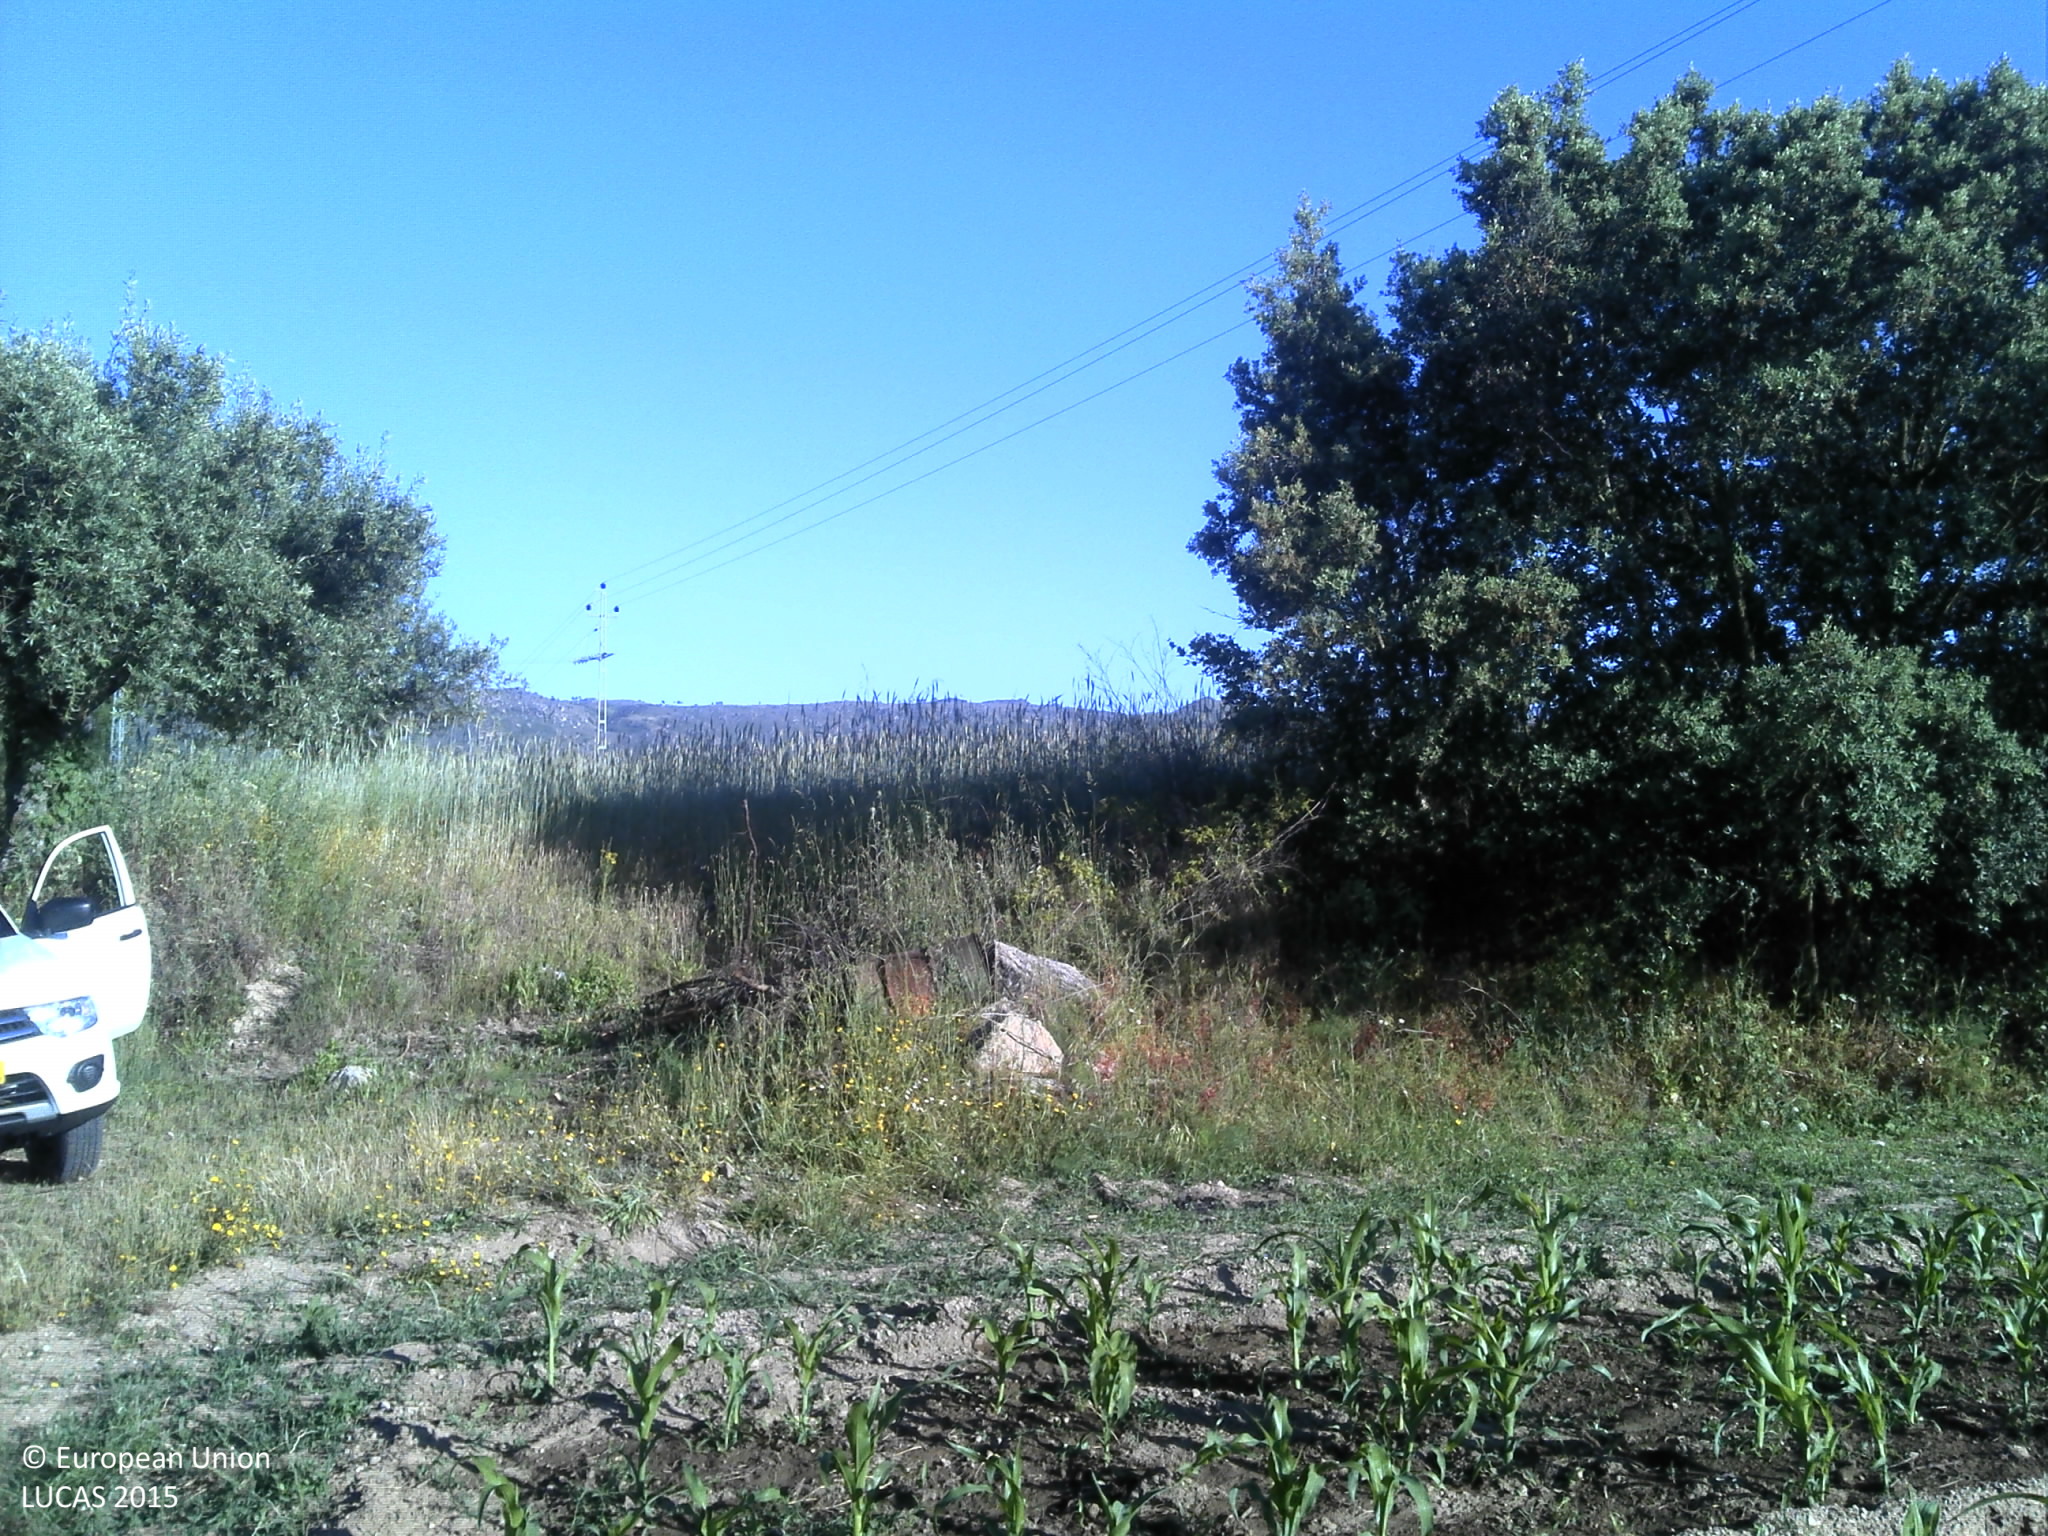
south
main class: Cropland
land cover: Maize
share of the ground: 10 - 25 %
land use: Agriculture (excluding fallow land and kitchen gardens)
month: May
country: PT
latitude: 40.6162
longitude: -7.3065
